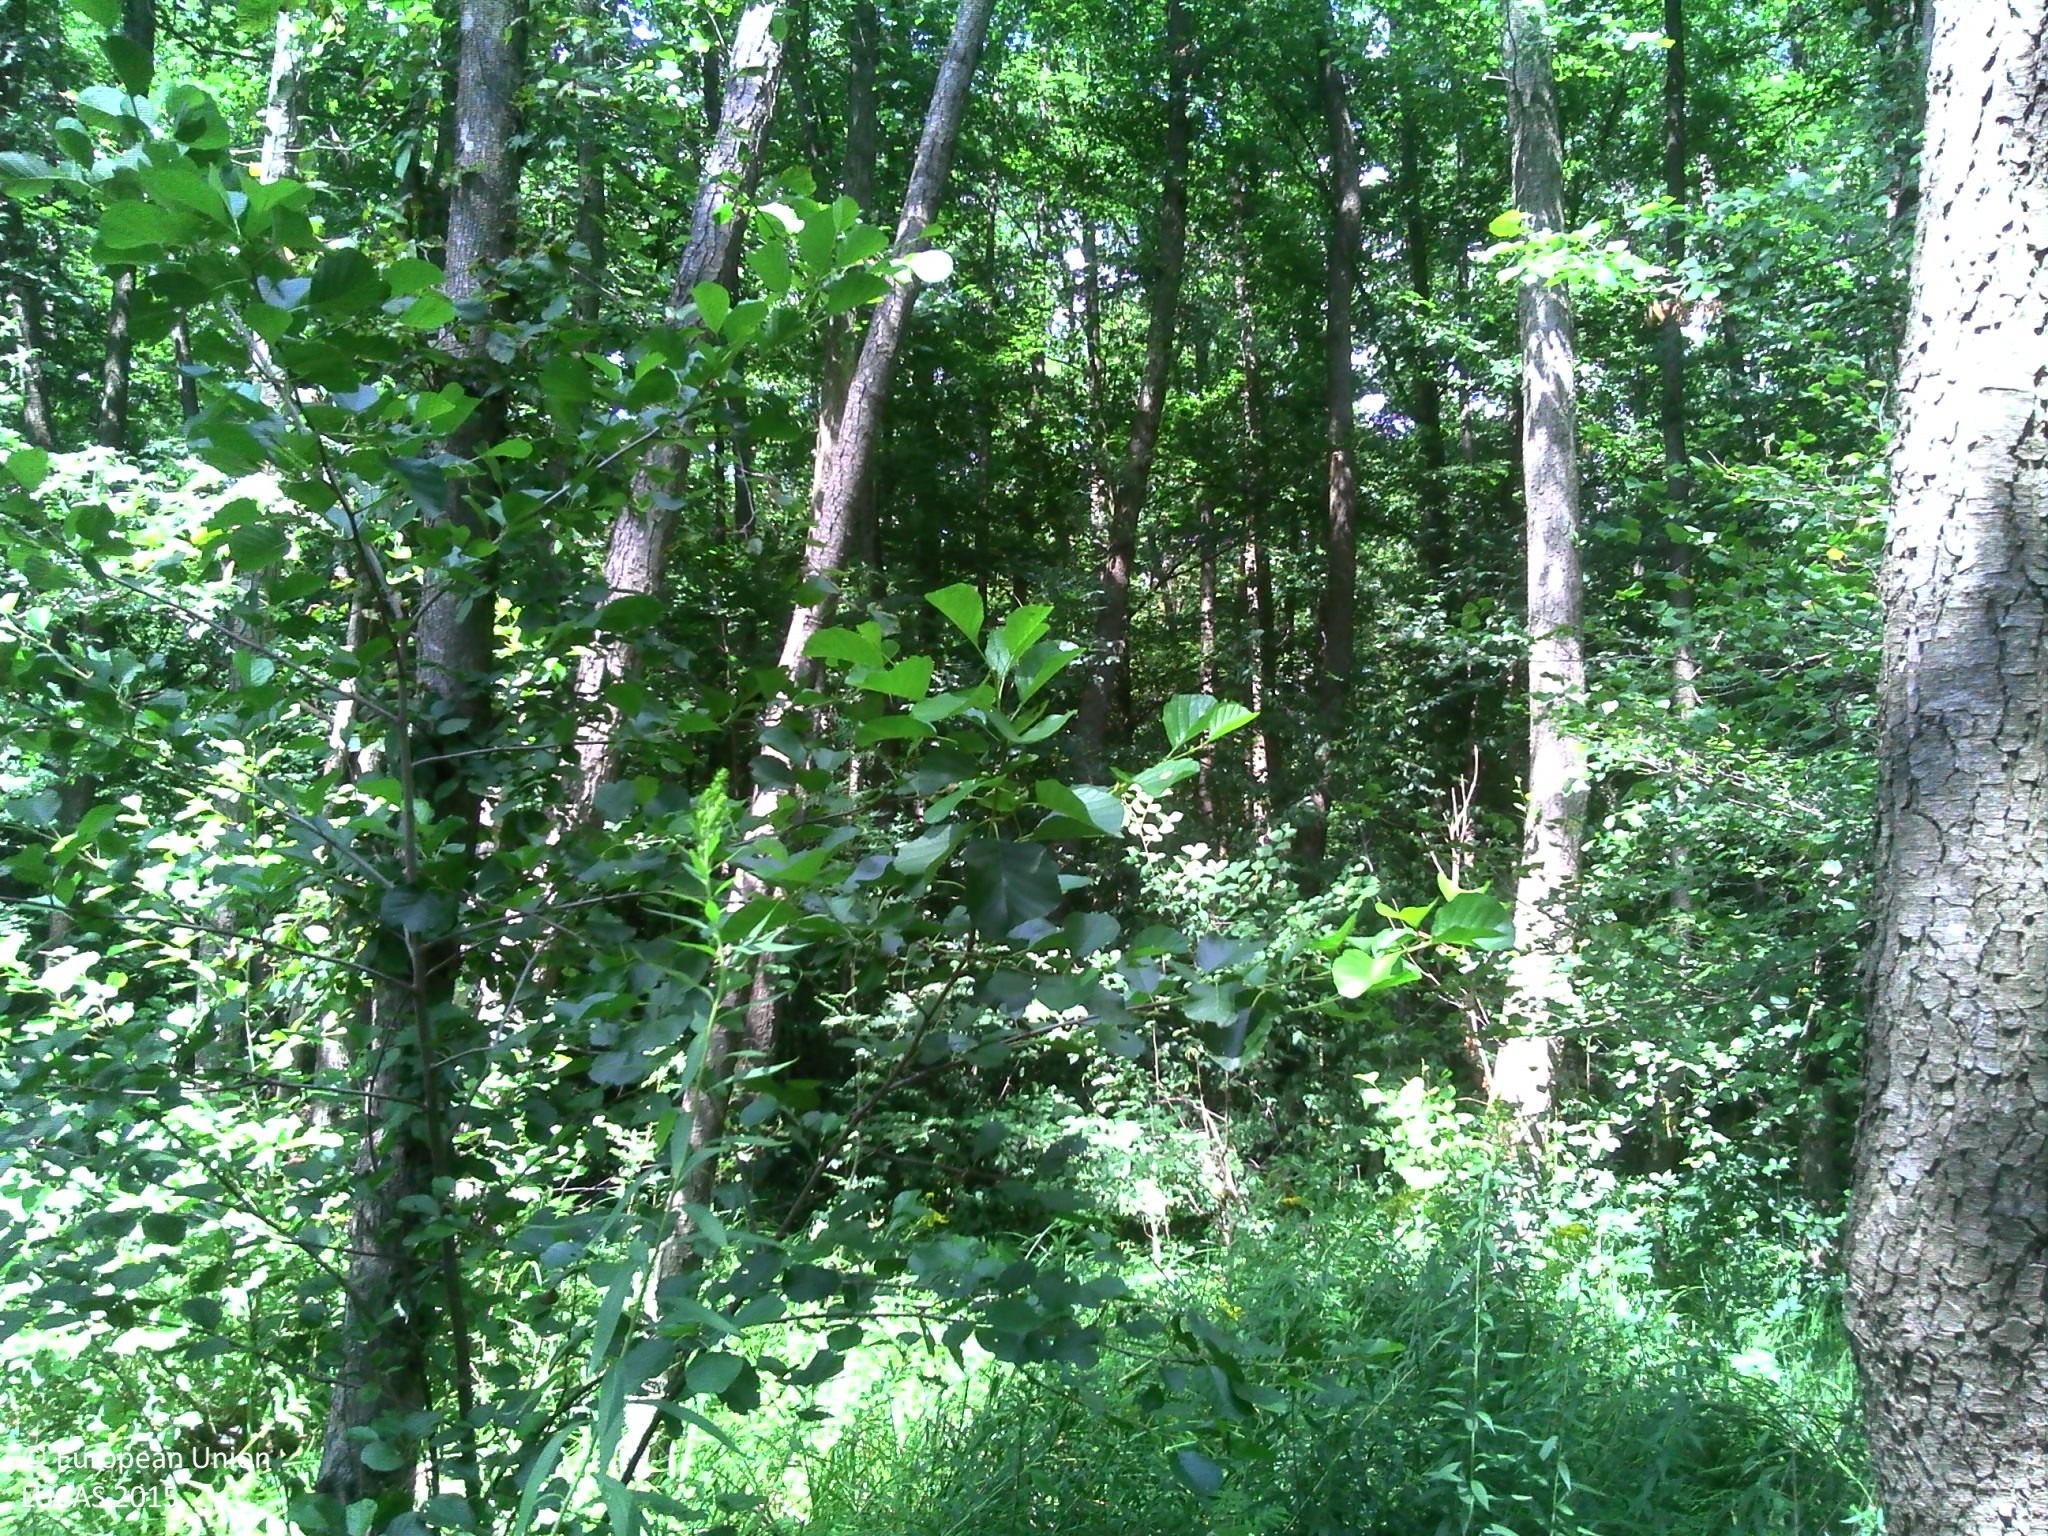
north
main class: Woodland
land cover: Broadleaved woodland
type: mesophytic deciduous forest
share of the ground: > 75 %
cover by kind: broadleaved forest trees 95 %, herbaceous plants 5 %
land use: Forestry
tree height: > 5 m
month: July
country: FR
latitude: 48.8301
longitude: 7.7257
